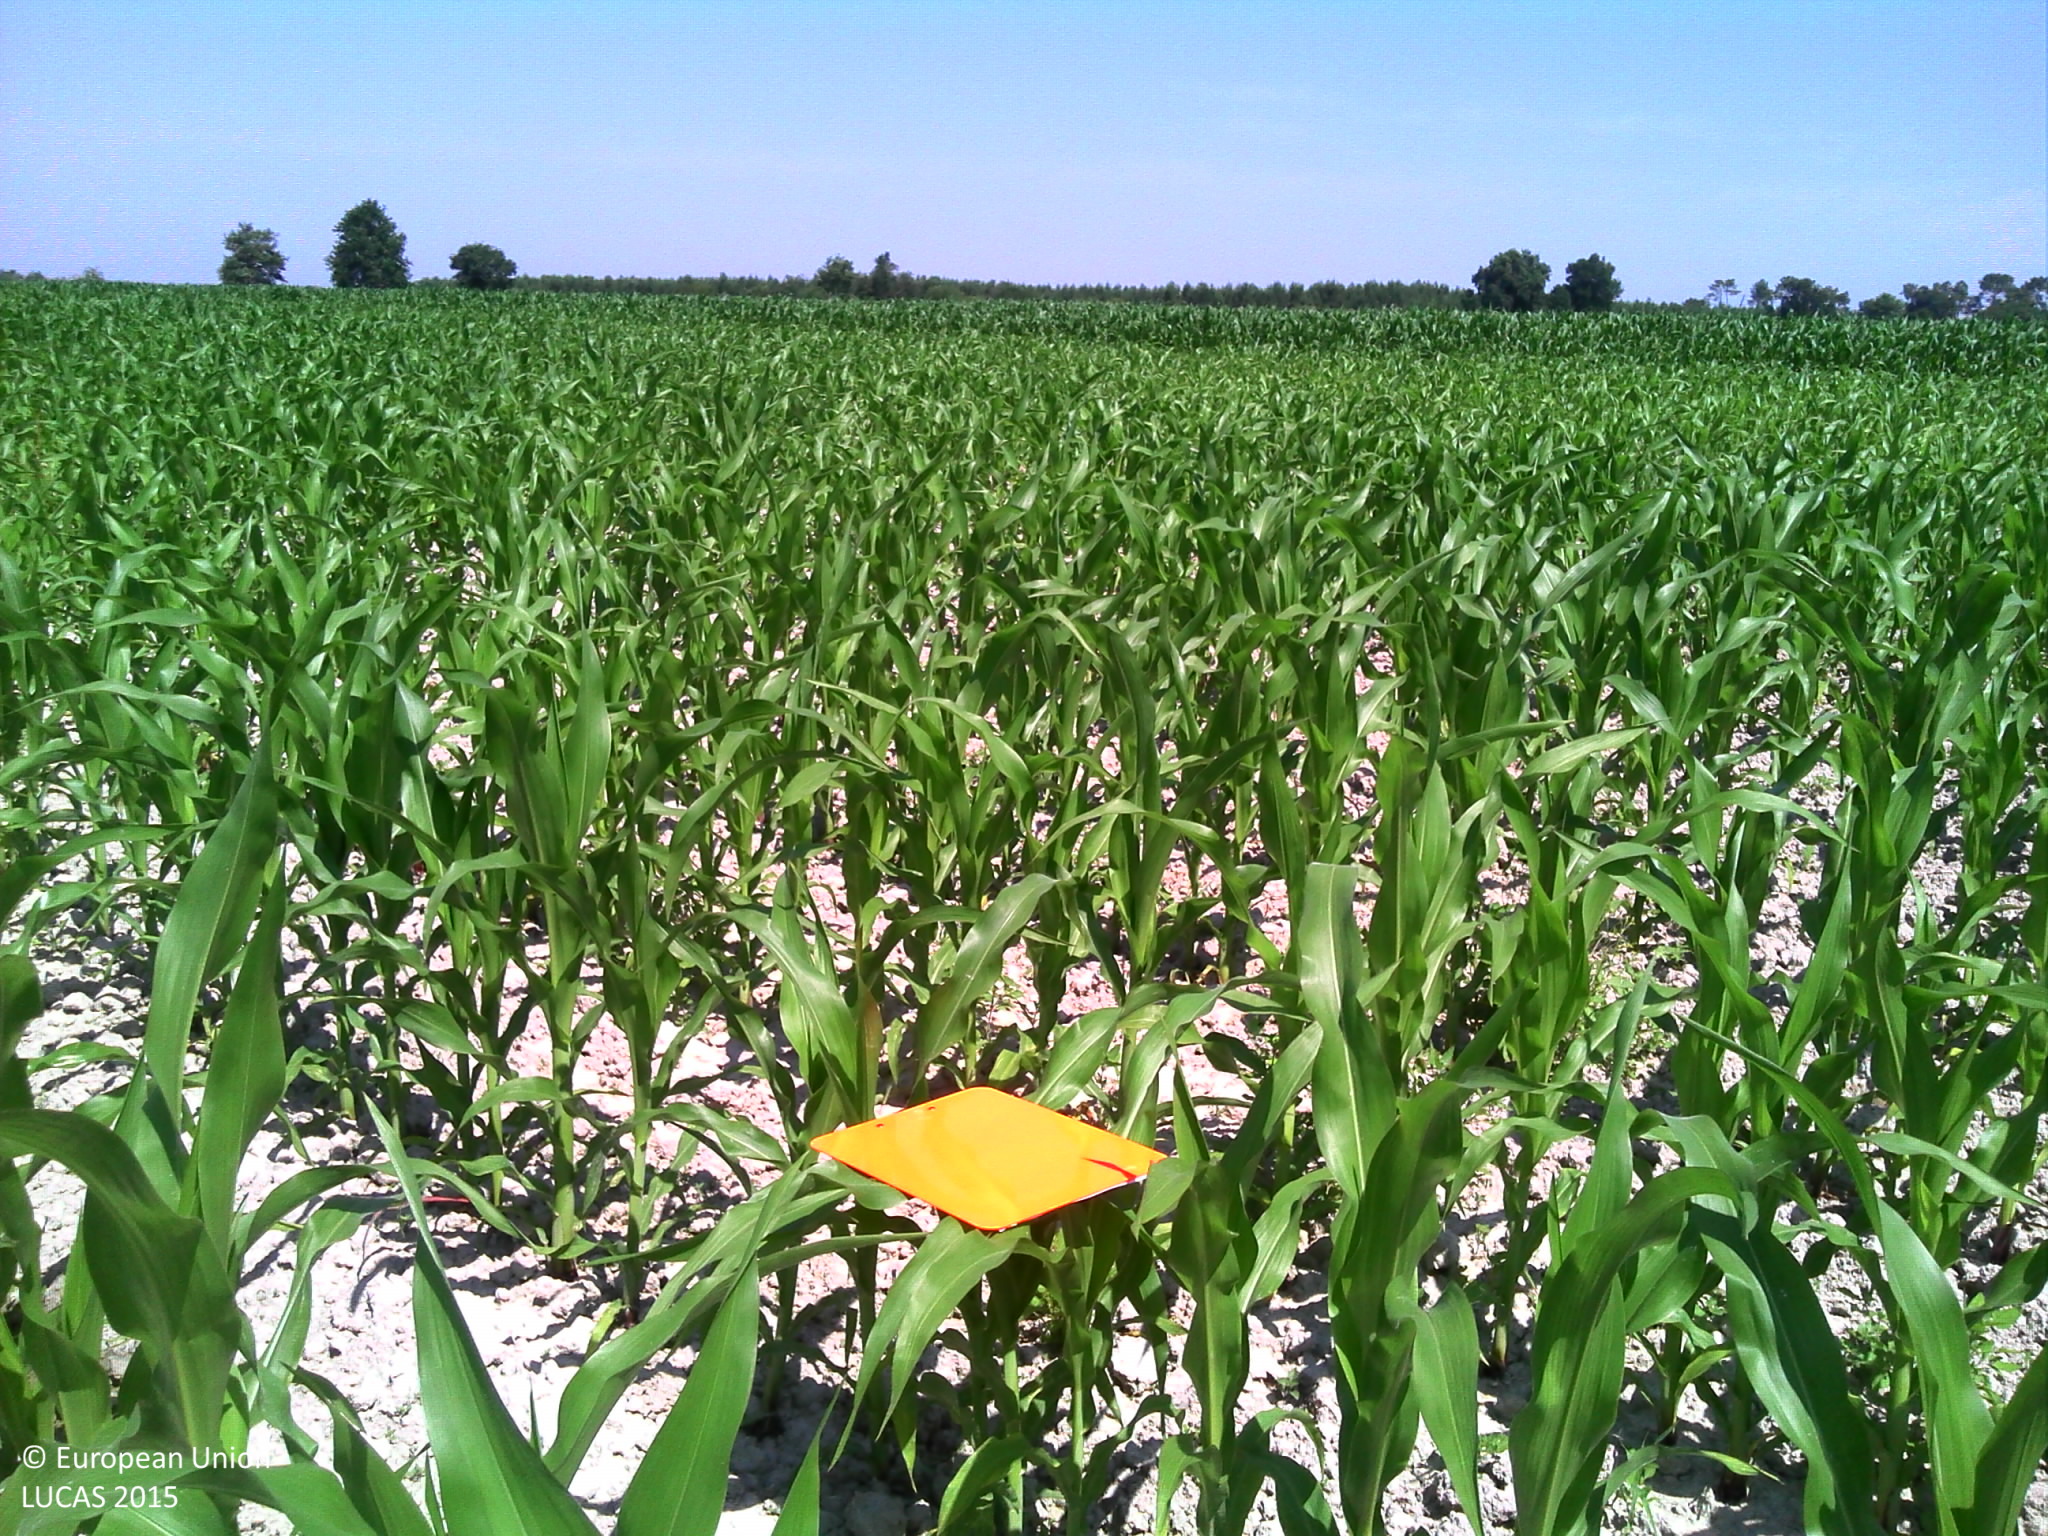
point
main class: Cropland
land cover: Maize
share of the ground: 50 - 75 %
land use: Agriculture (excluding fallow land and kitchen gardens)
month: June
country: FR
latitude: 43.6312
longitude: -0.5332
